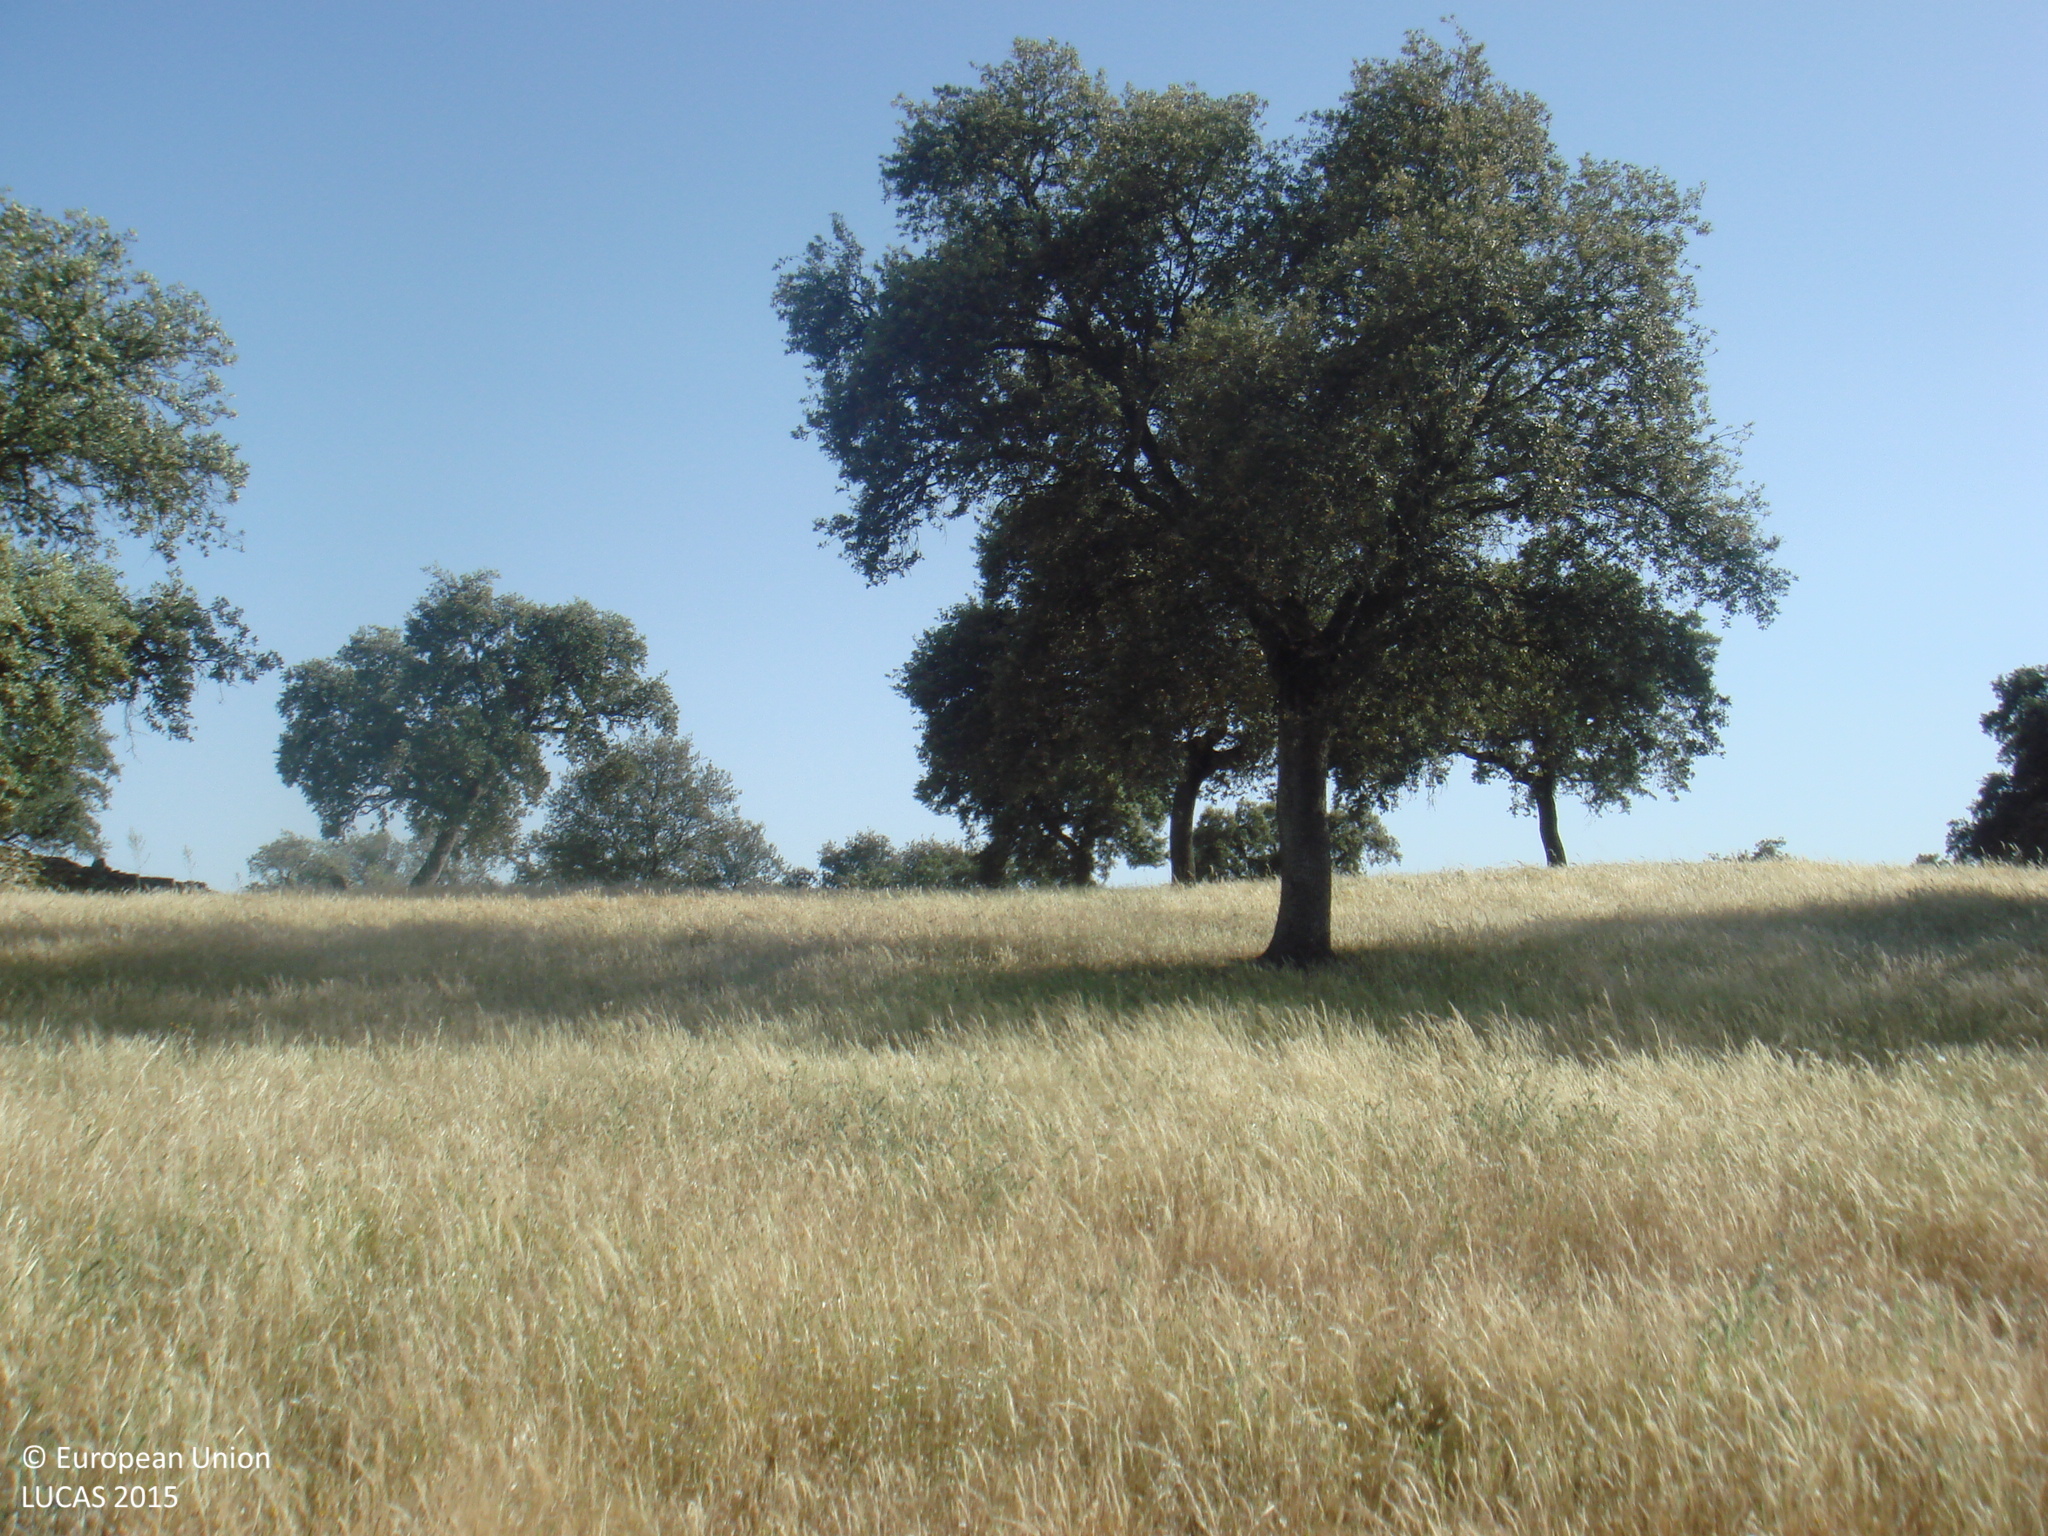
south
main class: Woodland
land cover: Broadleaved woodland
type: broadleaved evergreen forest
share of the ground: 25 - 50 %
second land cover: Spontaneously vegetated surfaces
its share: > 75 %
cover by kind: herbaceous plants 60 %, broadleaved forest trees 40 %
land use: Forestry
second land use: Agriculture (excluding fallow land and kitchen gardens)
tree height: > 5 m
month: May
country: ES
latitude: 38.5014
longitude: -4.7587
